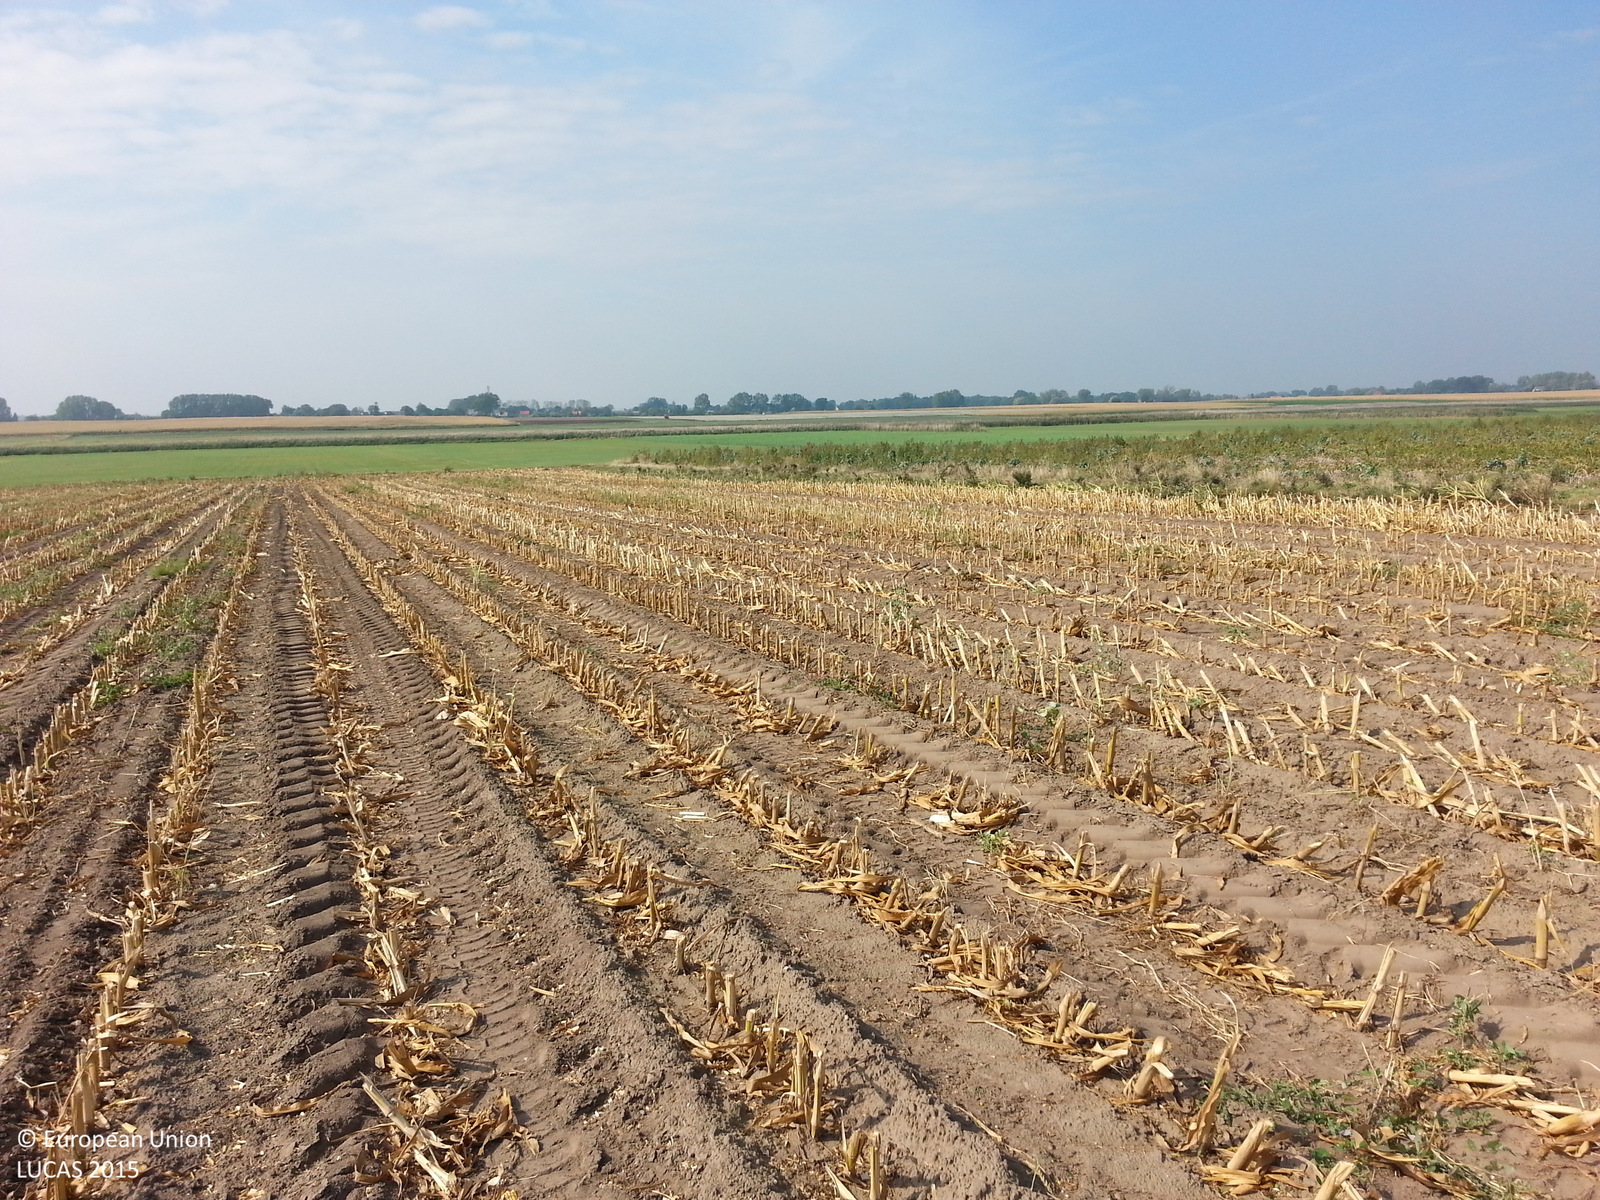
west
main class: Cropland
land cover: Maize
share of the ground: 25 - 50 %
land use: Agriculture (excluding fallow land and kitchen gardens)
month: September
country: PL
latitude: 52.9320
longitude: 18.0942
